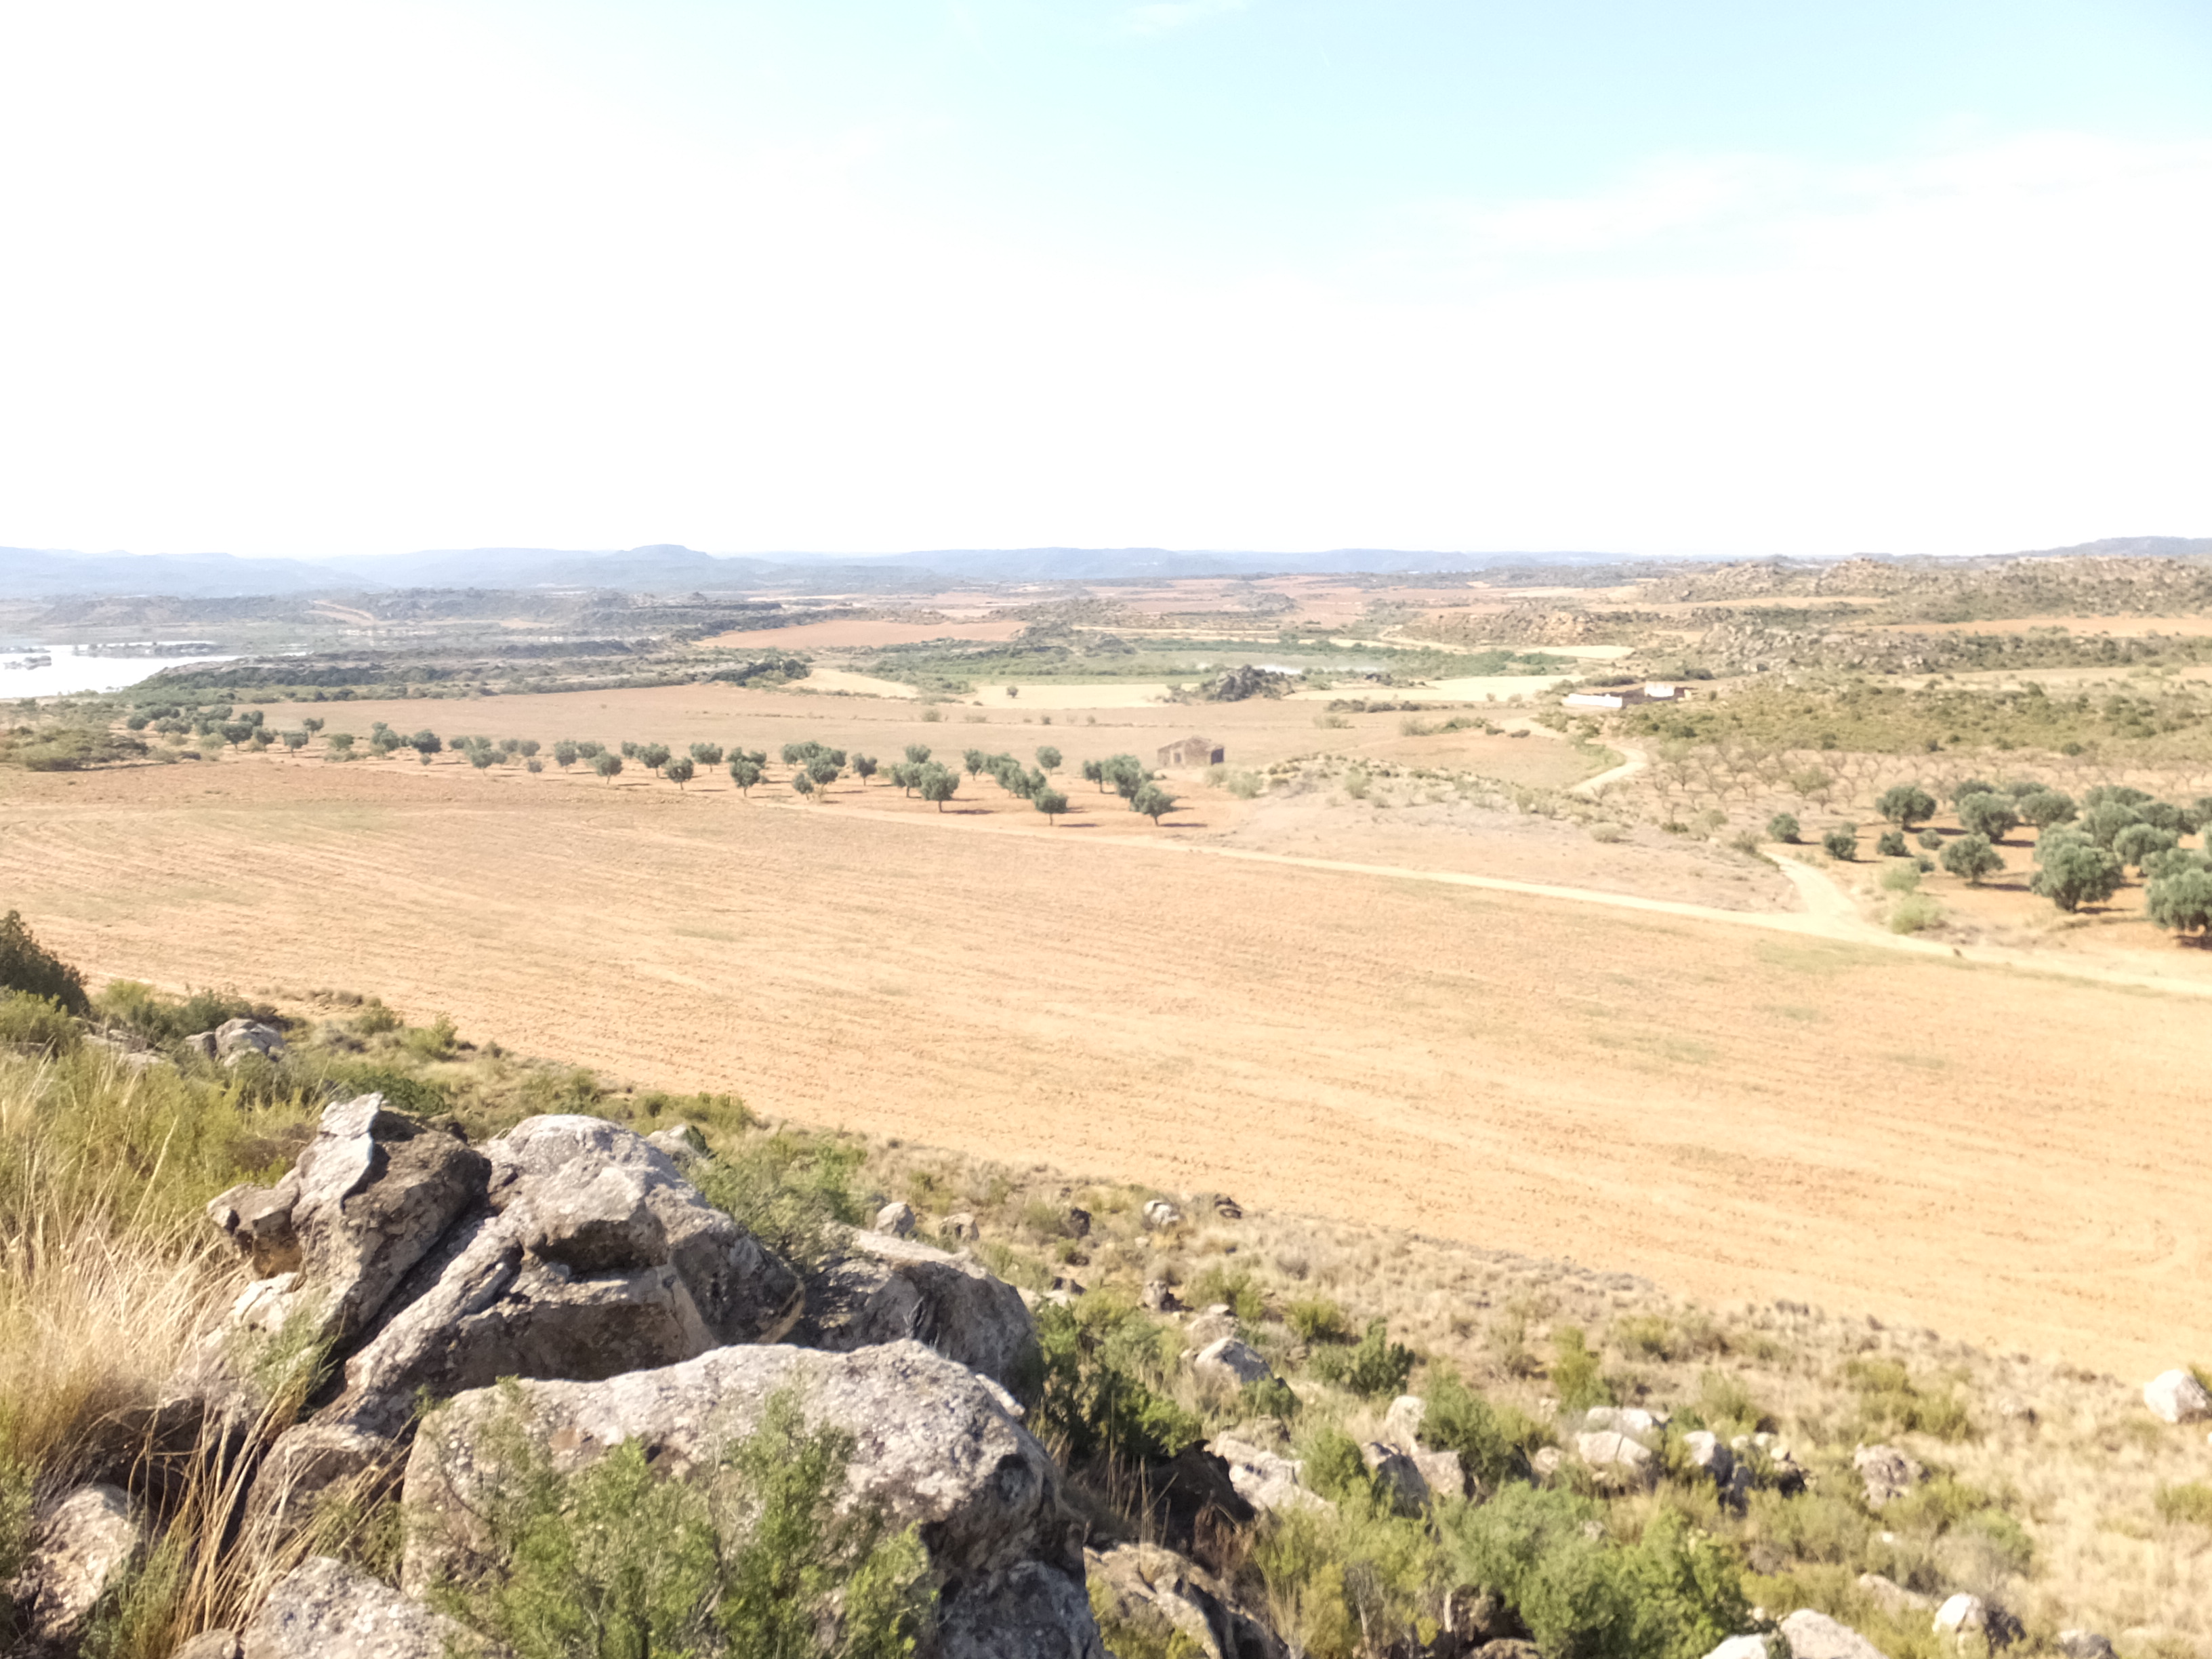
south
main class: Shrubland
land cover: Shrubland without tree cover
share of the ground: > 75 %
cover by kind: consolidated bare surface 50 %, shrubs 30 %, herbaceous plants 20 %
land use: Semi-natural and natural areas not in use
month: July
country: ES
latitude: 41.1540
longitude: -0.0333
